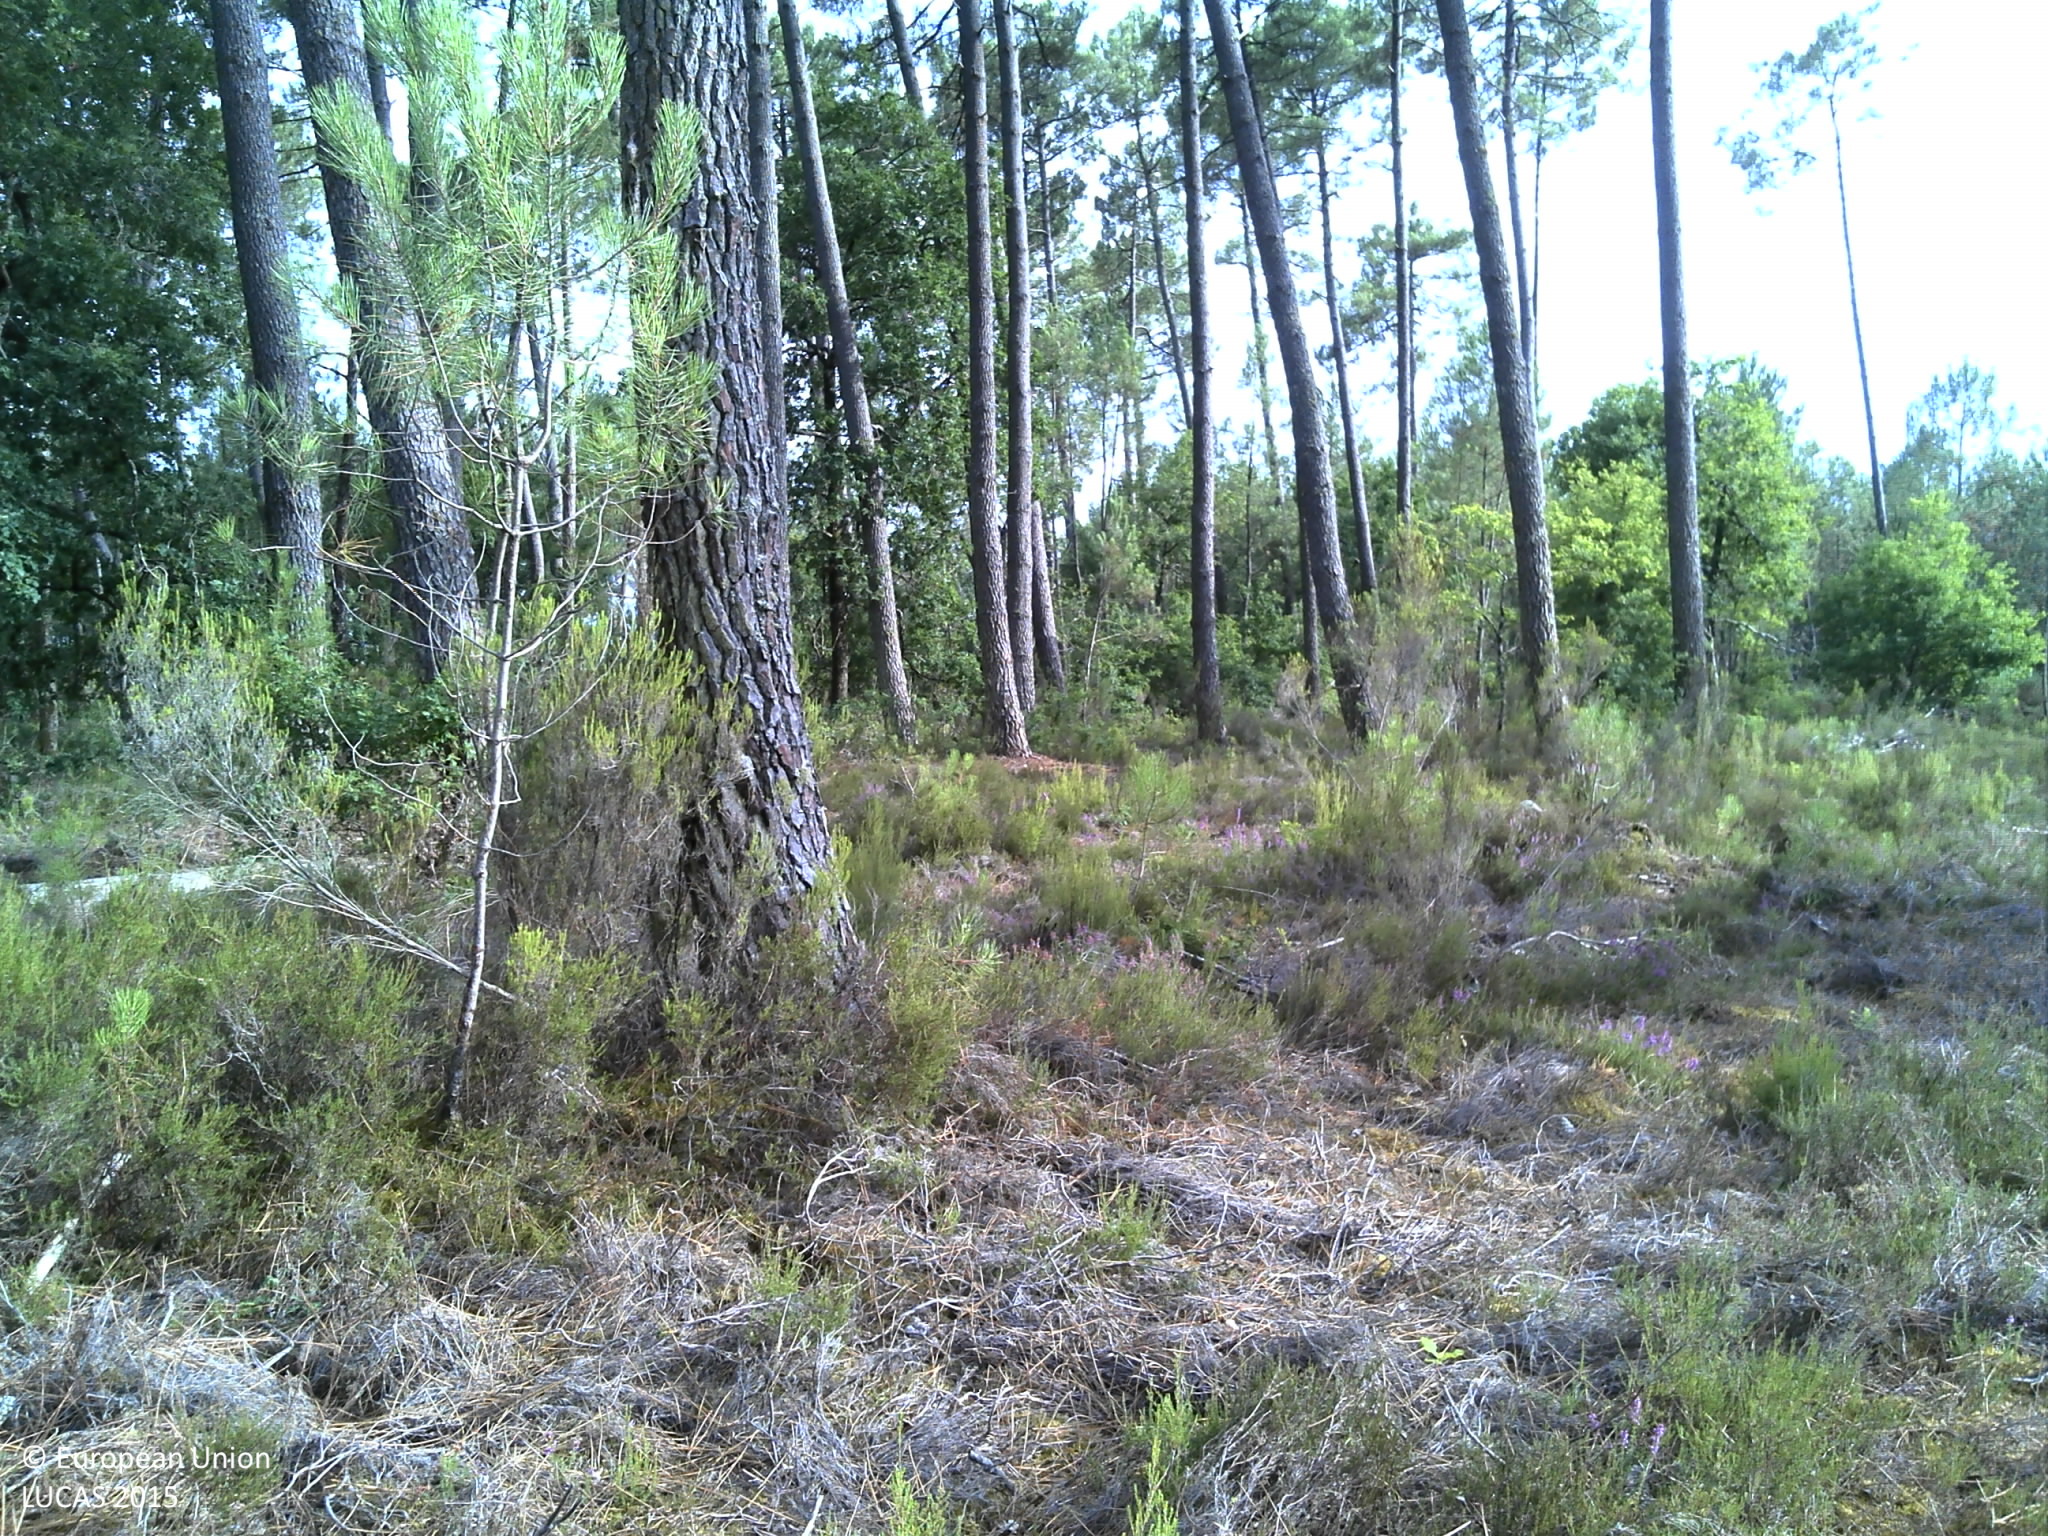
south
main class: Woodland
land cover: Pine dominated coniferous woodland
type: coniferous forest of the mediterranean region
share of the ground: 50 - 75 %
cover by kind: coniferous forest trees 60 %, shrubs 30 %, herbaceous plants 5 %, lichens and mosses 5 %
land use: Forestry
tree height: > 5 m
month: July
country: FR
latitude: 44.5021
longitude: -0.8990
